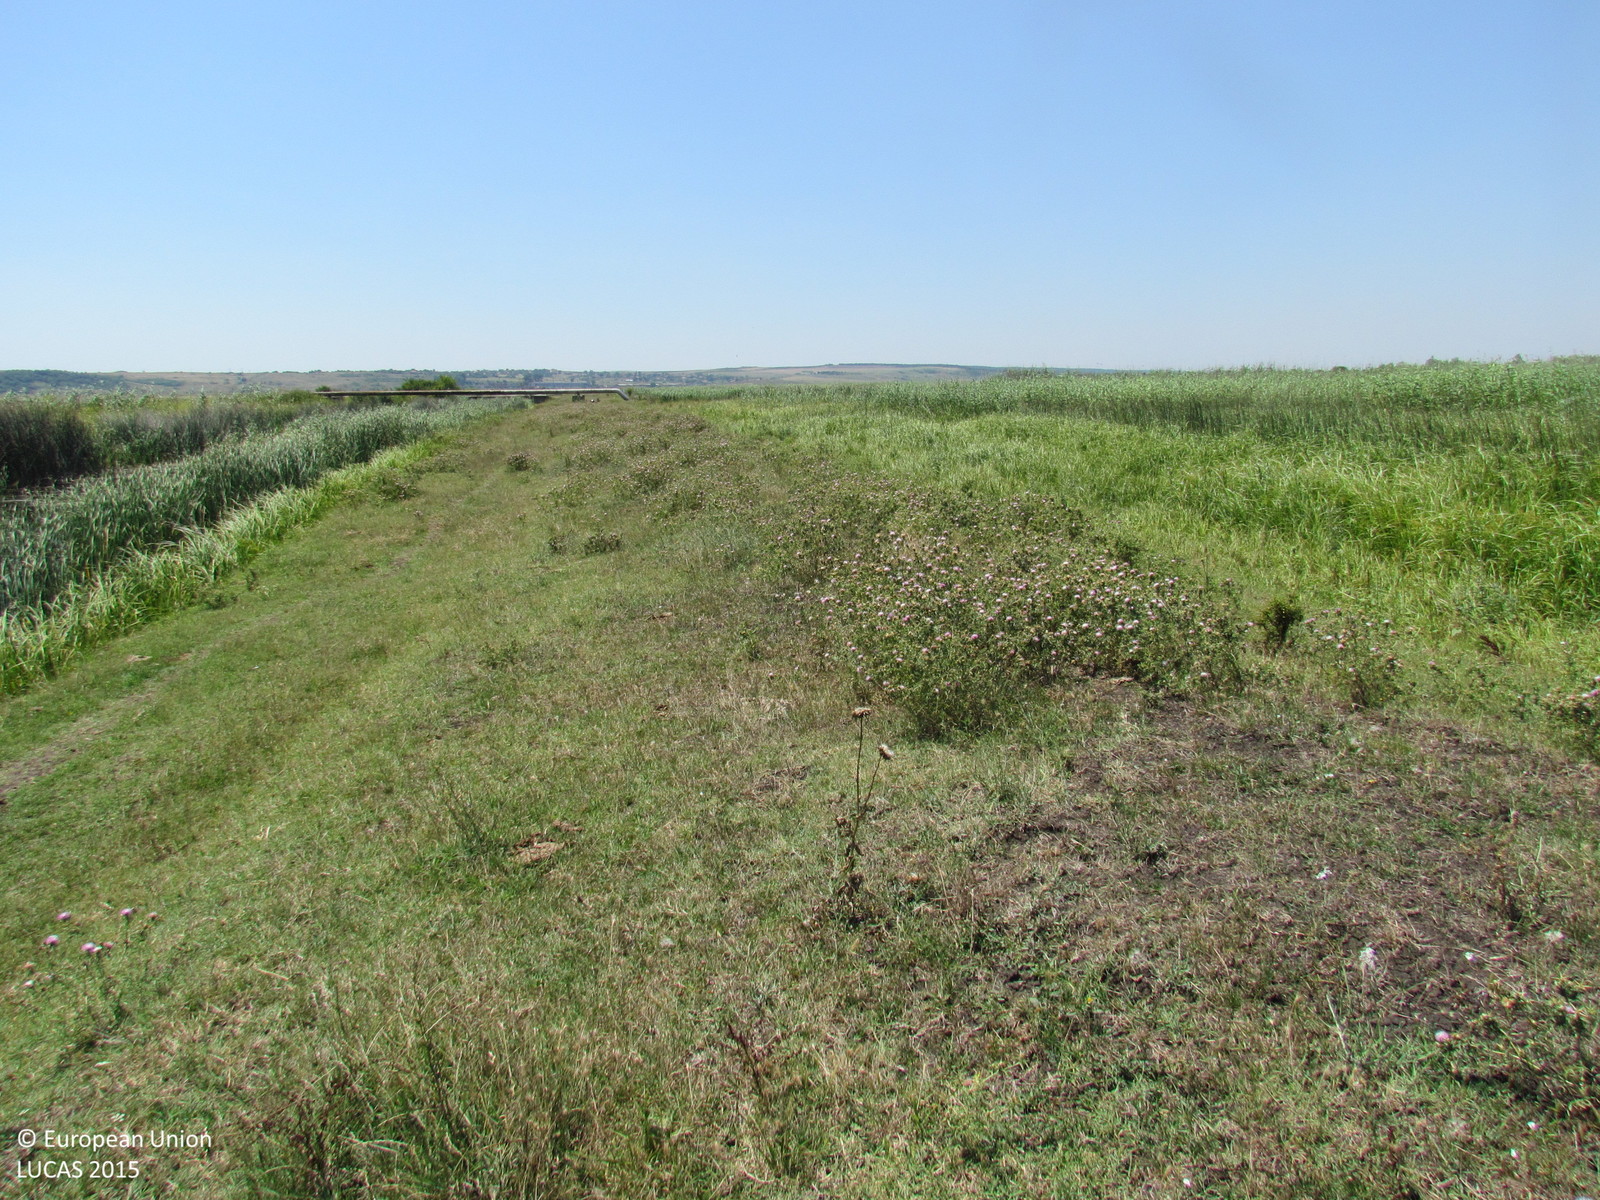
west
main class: Grassland
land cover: Spontaneously vegetated surfaces
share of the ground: > 75 %
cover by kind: herbaceous plants 100 %
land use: Fallow land
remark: Temporary flooded
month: July
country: BG
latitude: 42.4044
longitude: 27.3035
